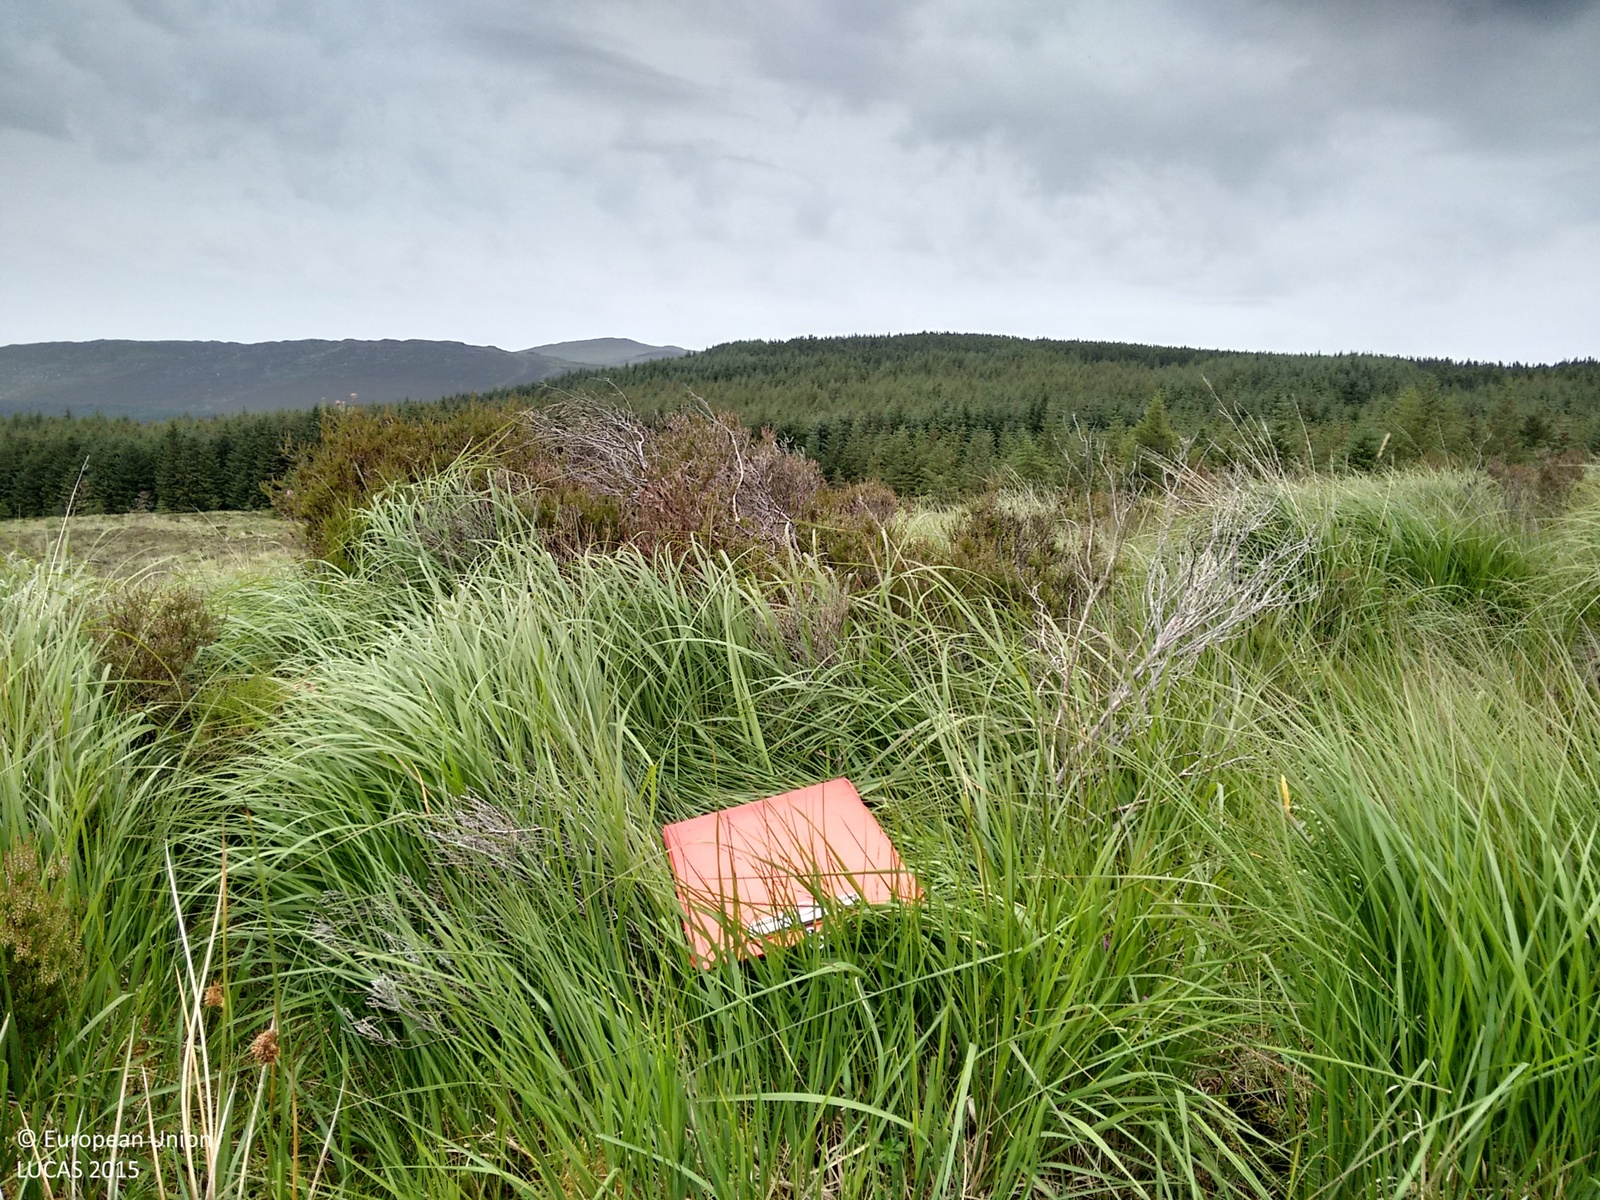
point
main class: Shrubland
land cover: Shrubland without tree cover
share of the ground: > 75 %
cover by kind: shrubs 60 %, herbaceous plants 40 %
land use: Semi-natural and natural areas not in use
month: July
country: IE
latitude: 53.0875
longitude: -6.3527
